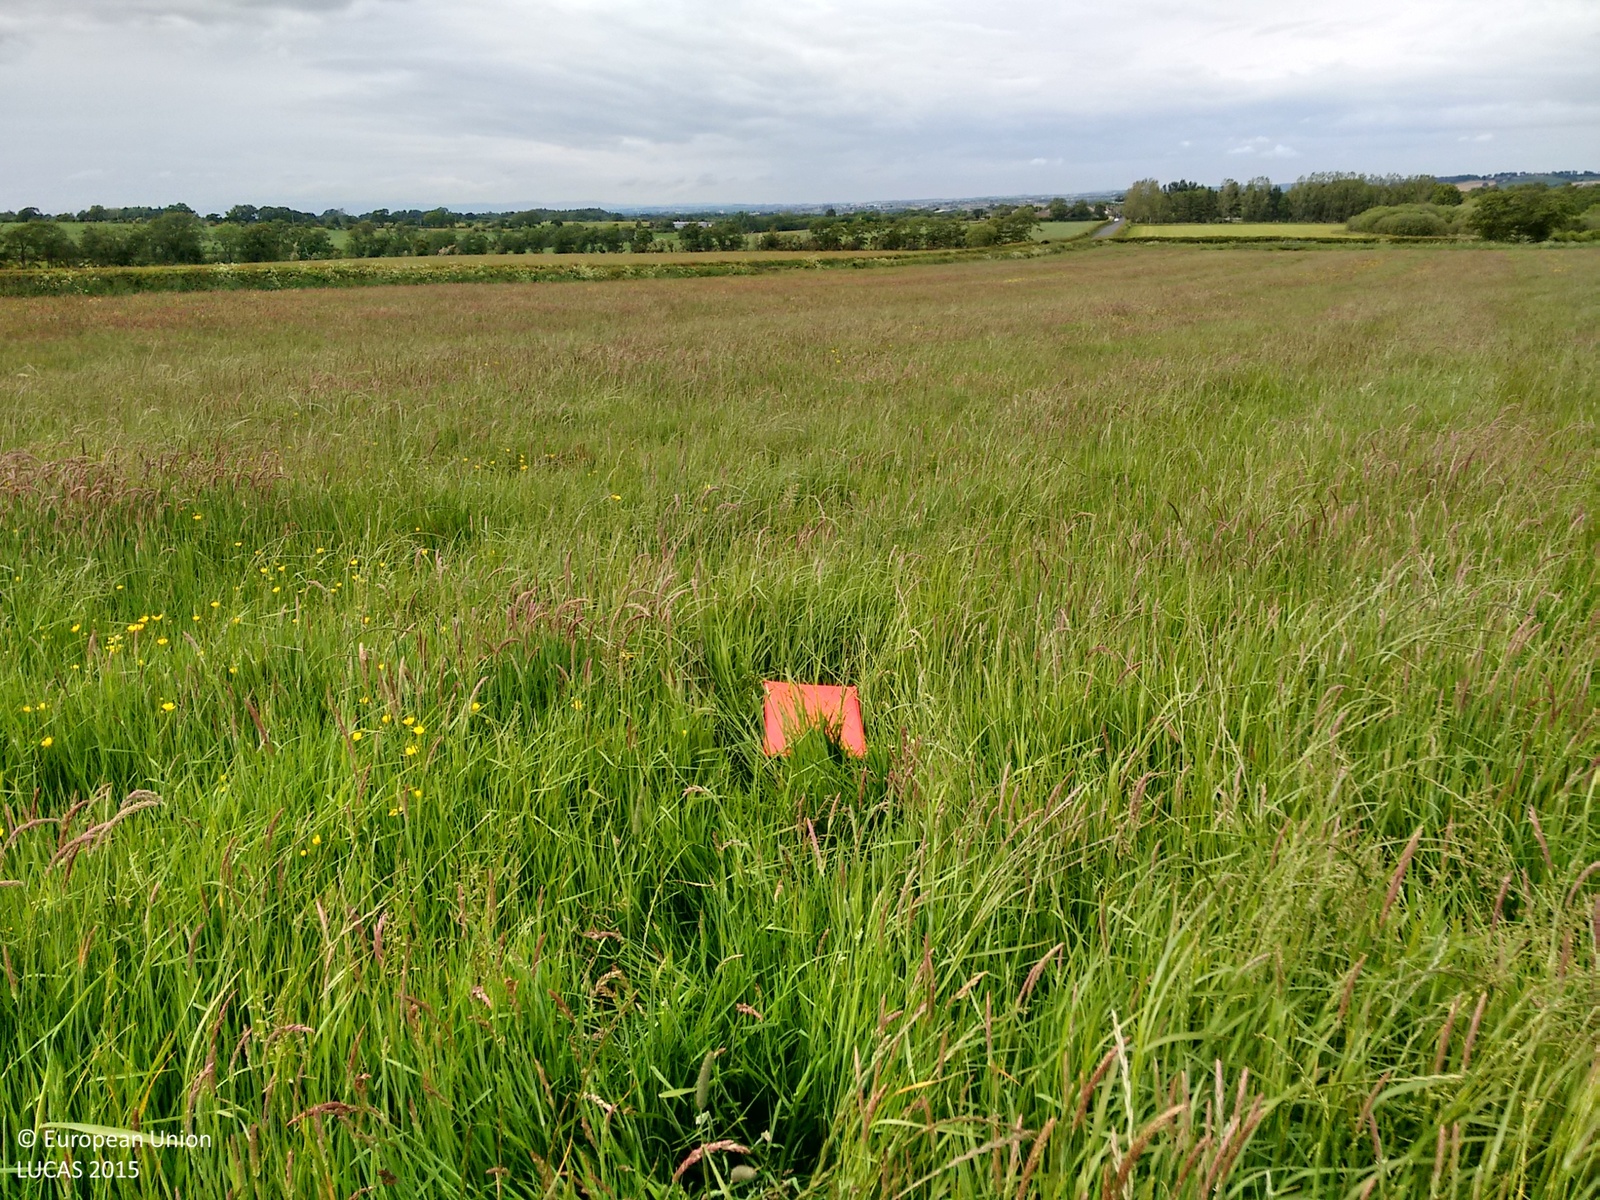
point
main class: Grassland
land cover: Grassland without tree/shrub cover
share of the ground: > 75 %
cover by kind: herbaceous plants 100 %
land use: Agriculture (excluding fallow land and kitchen gardens)
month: June
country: GB
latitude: 55.6988
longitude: -3.9133
